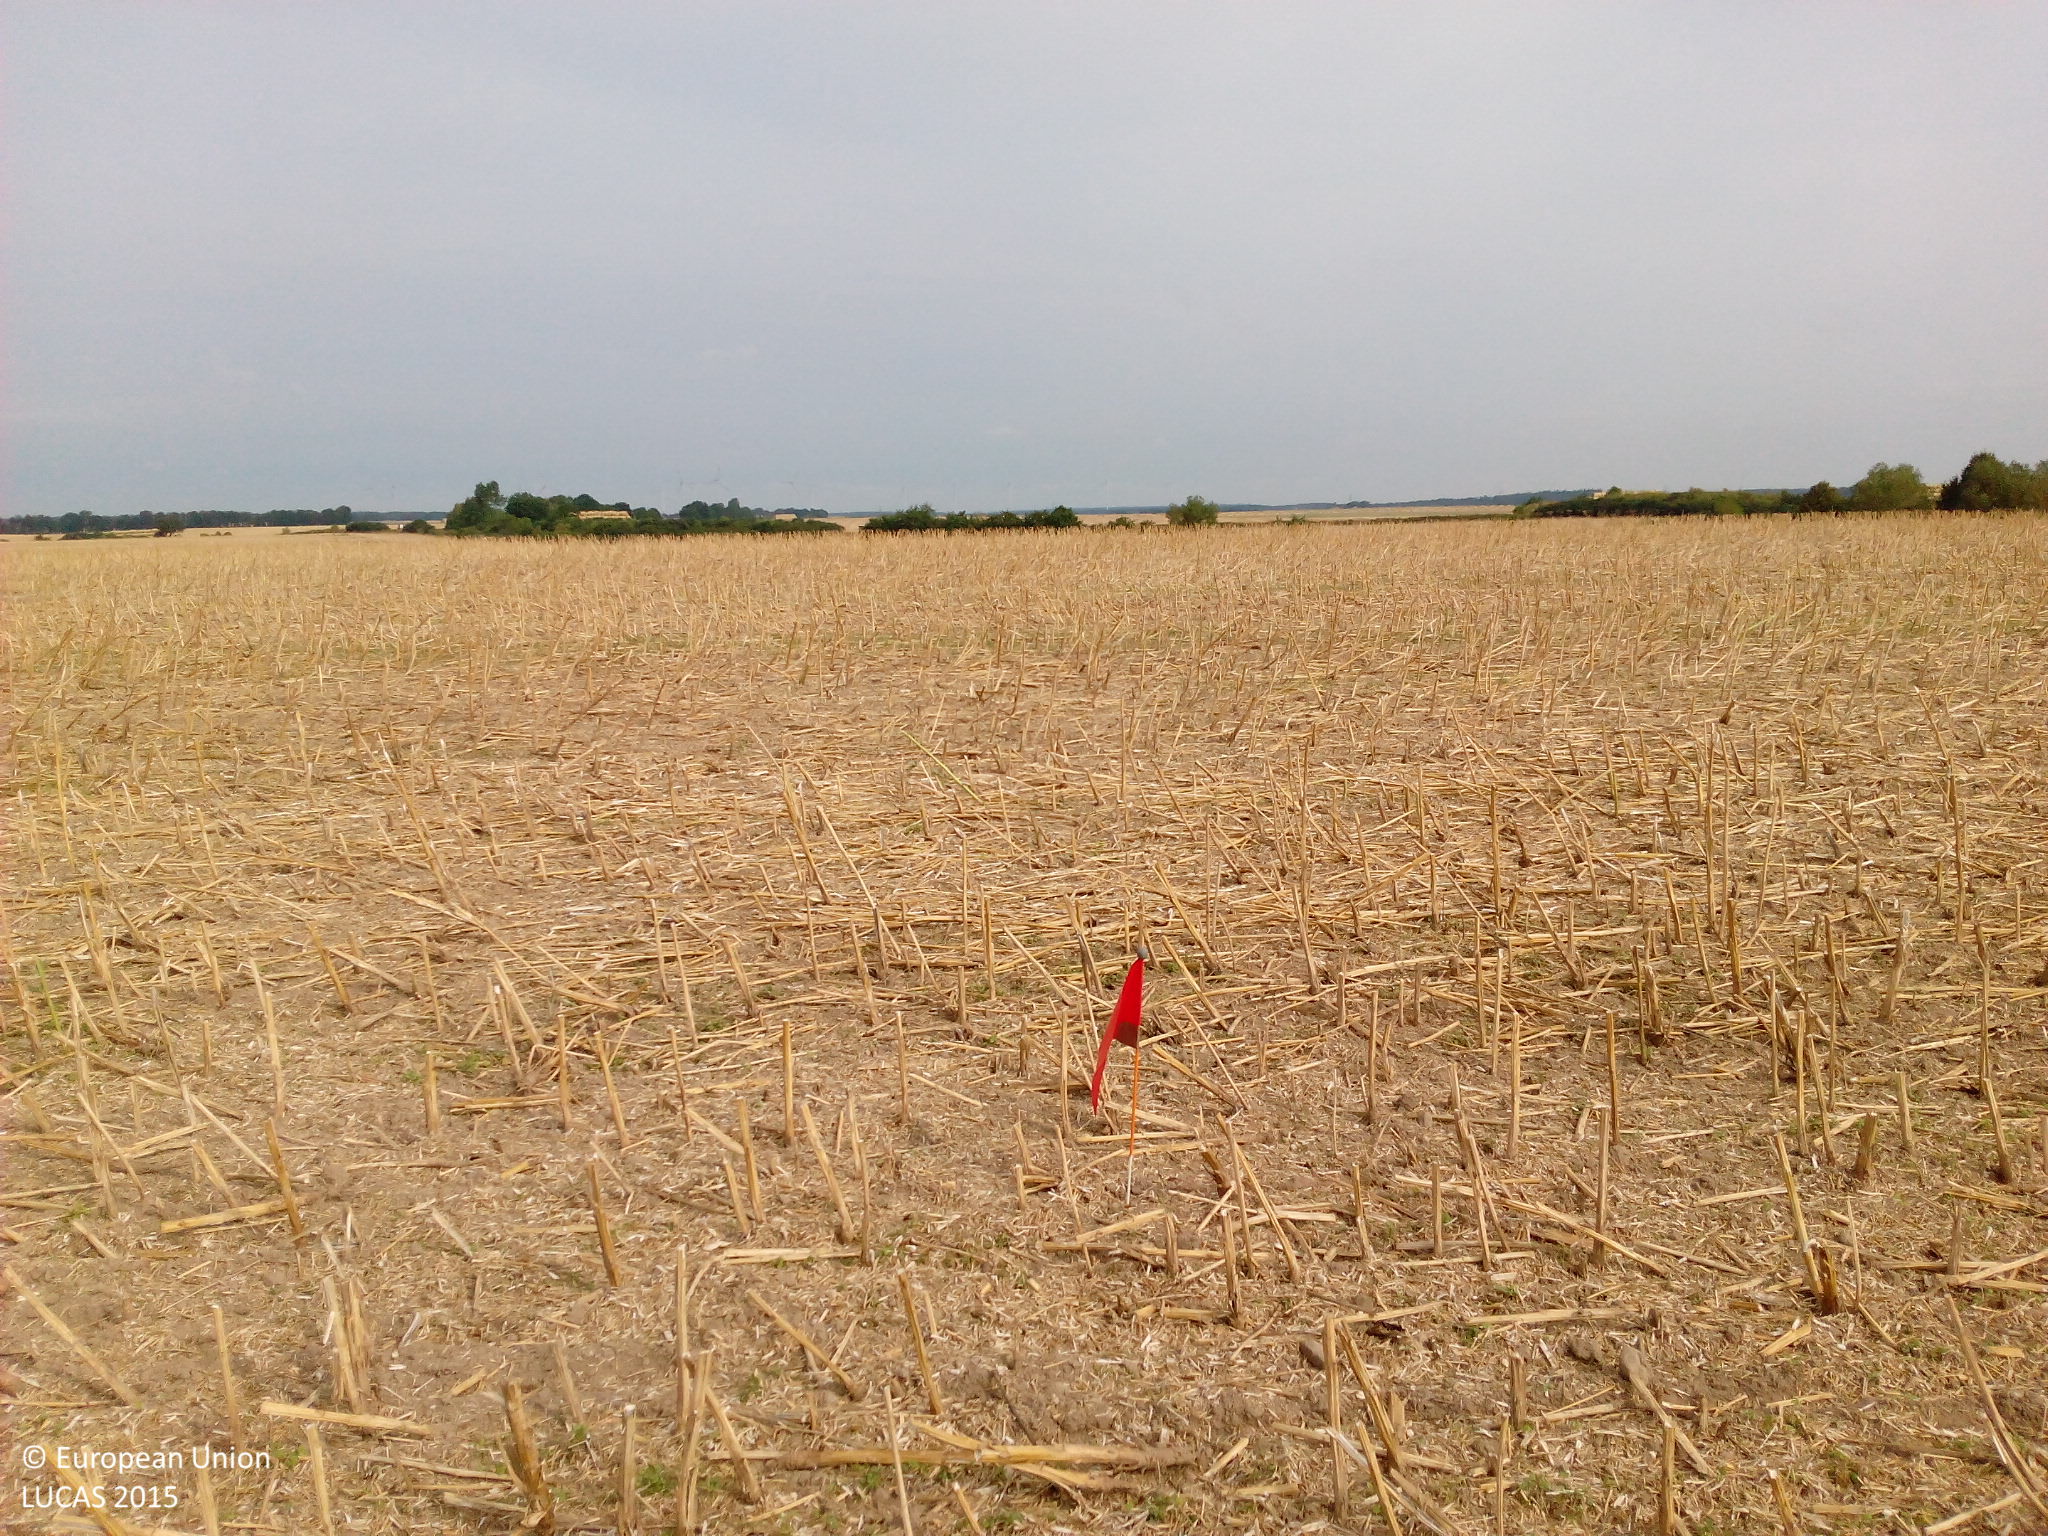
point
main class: Cropland
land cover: Rape and turnip rape
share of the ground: < 10 %
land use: Agriculture (excluding fallow land and kitchen gardens)
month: August
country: DE
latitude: 53.5931
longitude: 13.2177
